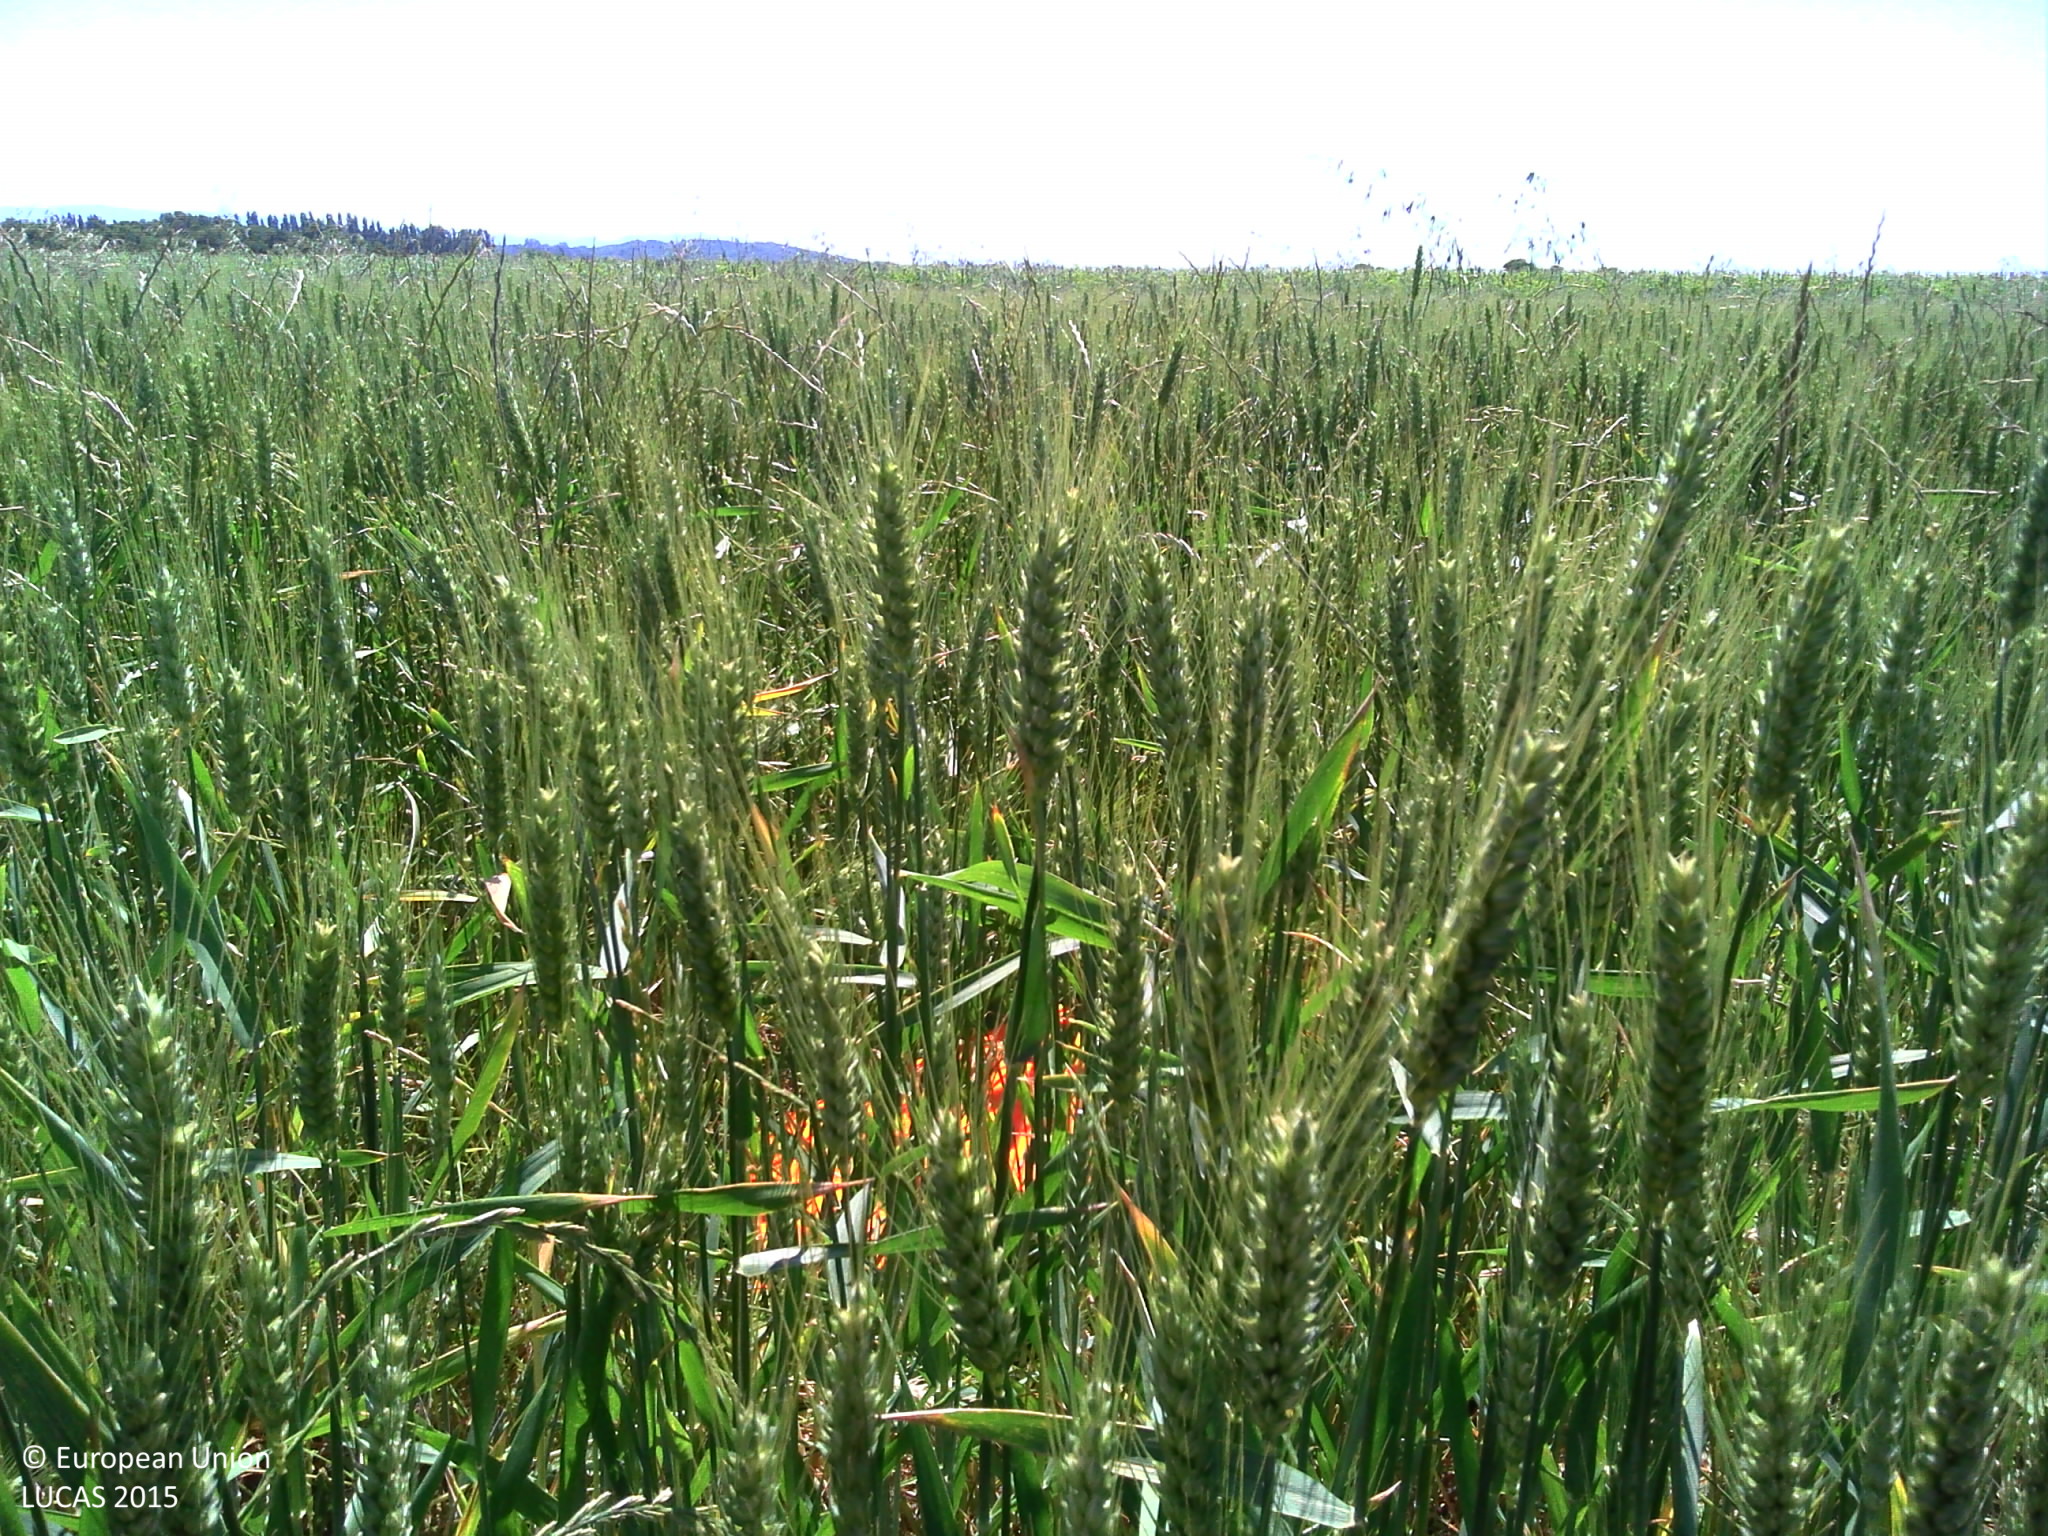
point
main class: Cropland
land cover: Common wheat
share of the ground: > 75 %
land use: Agriculture (excluding fallow land and kitchen gardens)
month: May
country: FR
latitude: 45.0388
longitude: 4.9150
